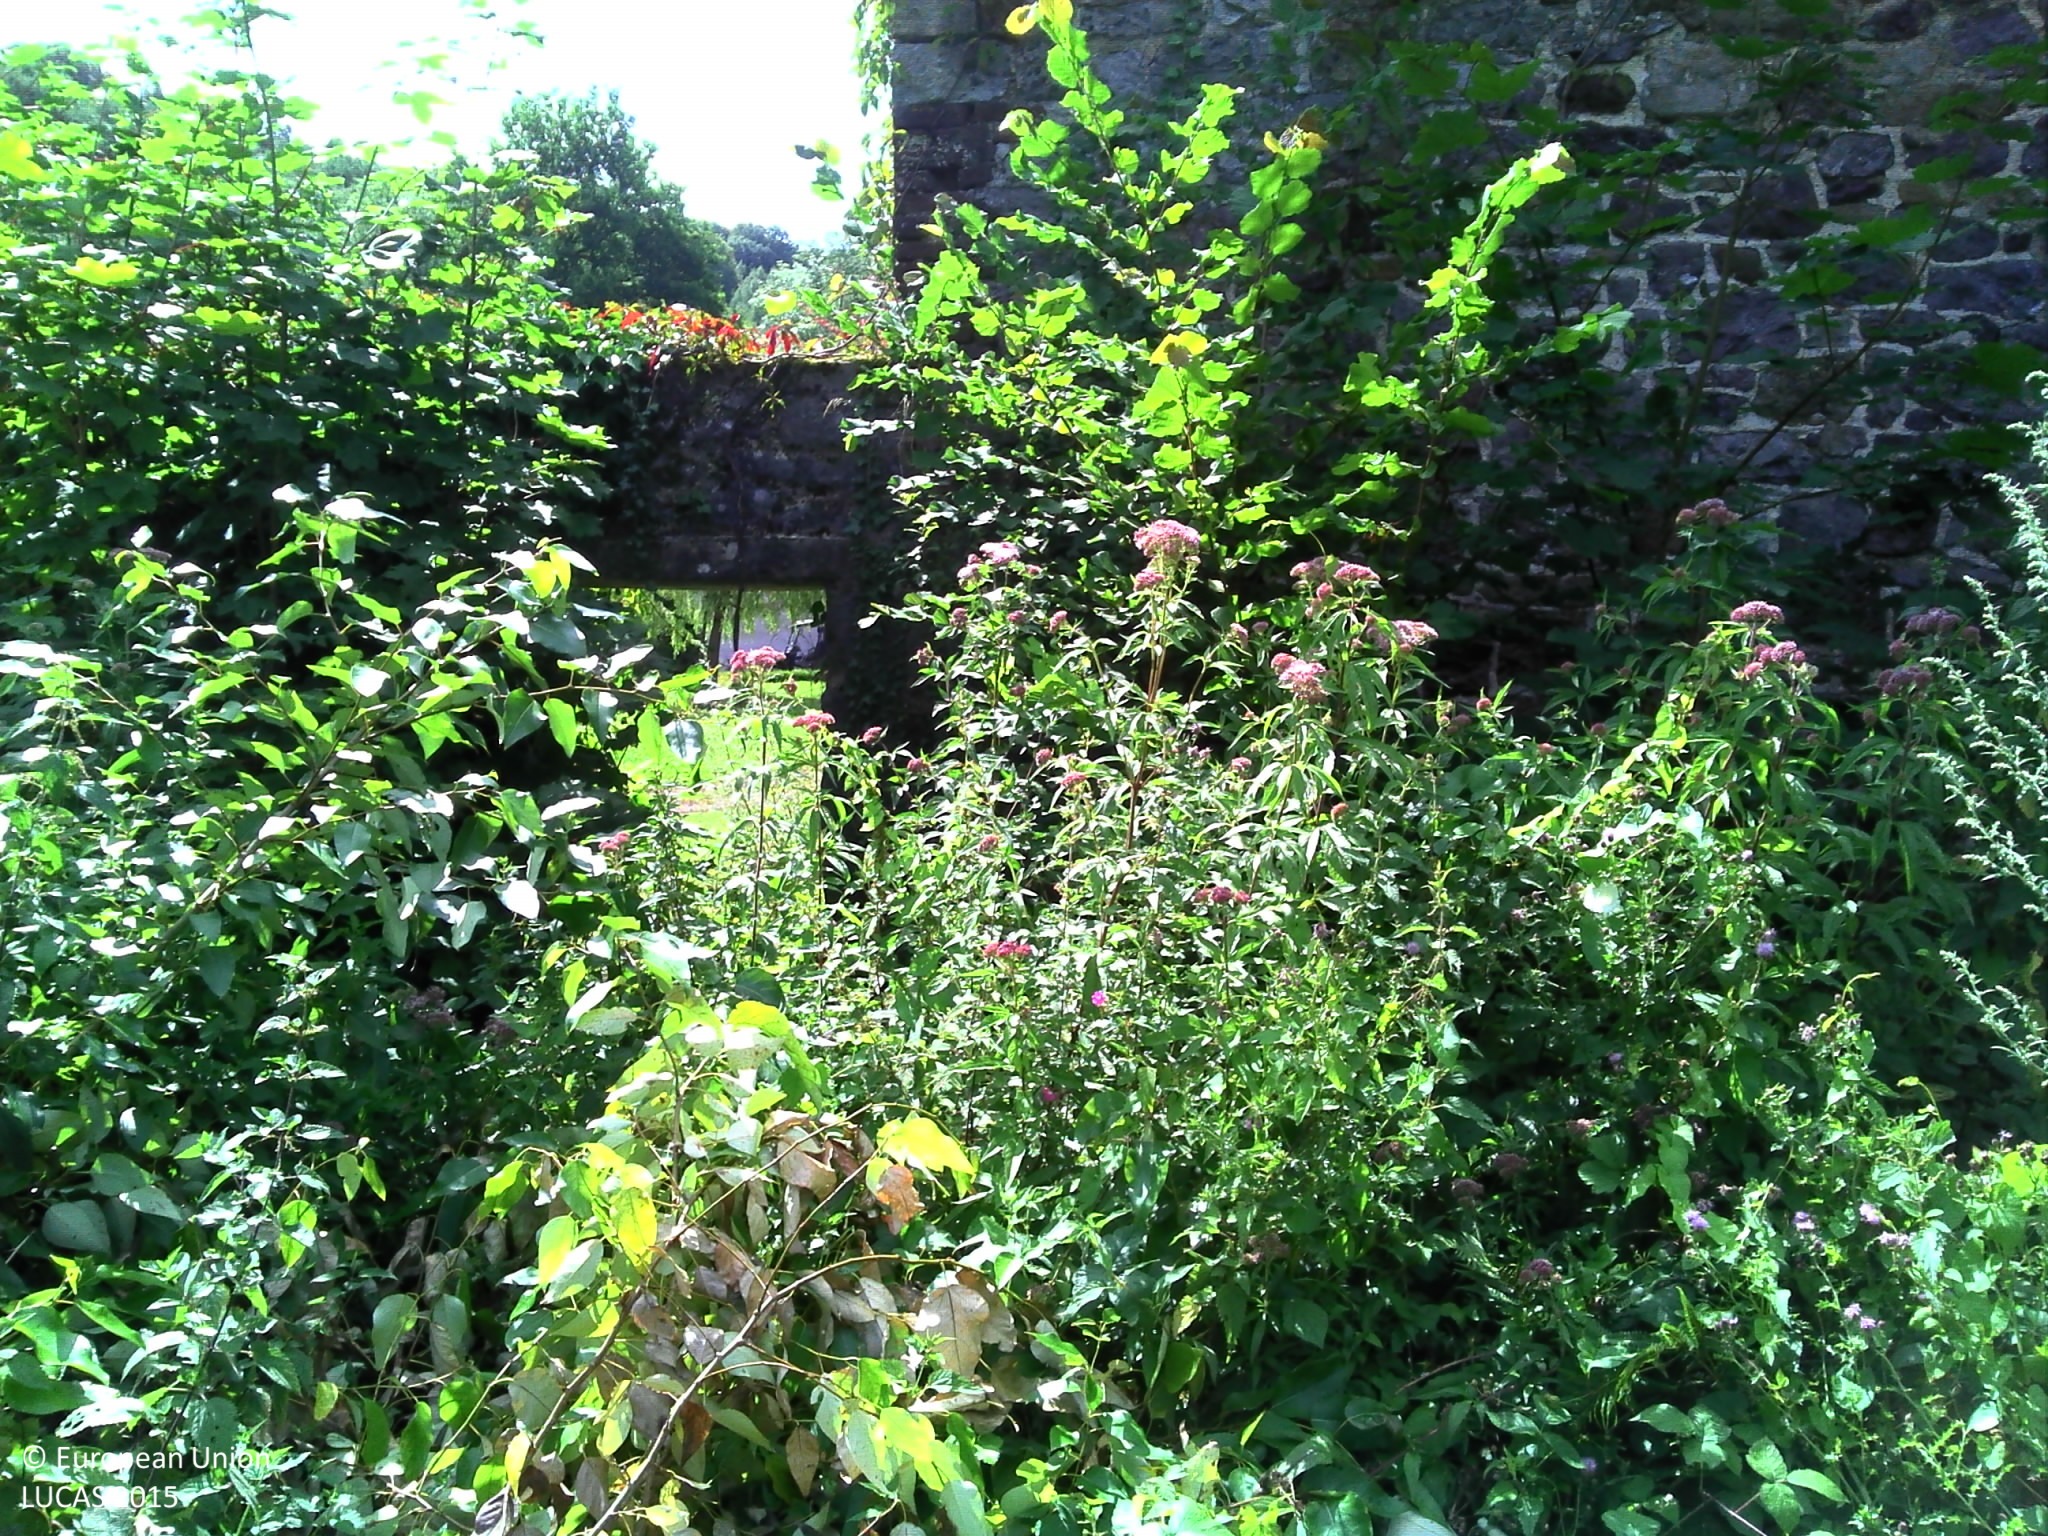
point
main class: Shrubland
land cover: Shrubland with sparse tree cover
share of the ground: > 75 %
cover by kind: shrubs 50 %, herbaceous plants 45 %, broadleaved forest trees 5 %
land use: Semi-natural and natural areas not in use
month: August
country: BE
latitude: 50.3620
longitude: 4.5841
